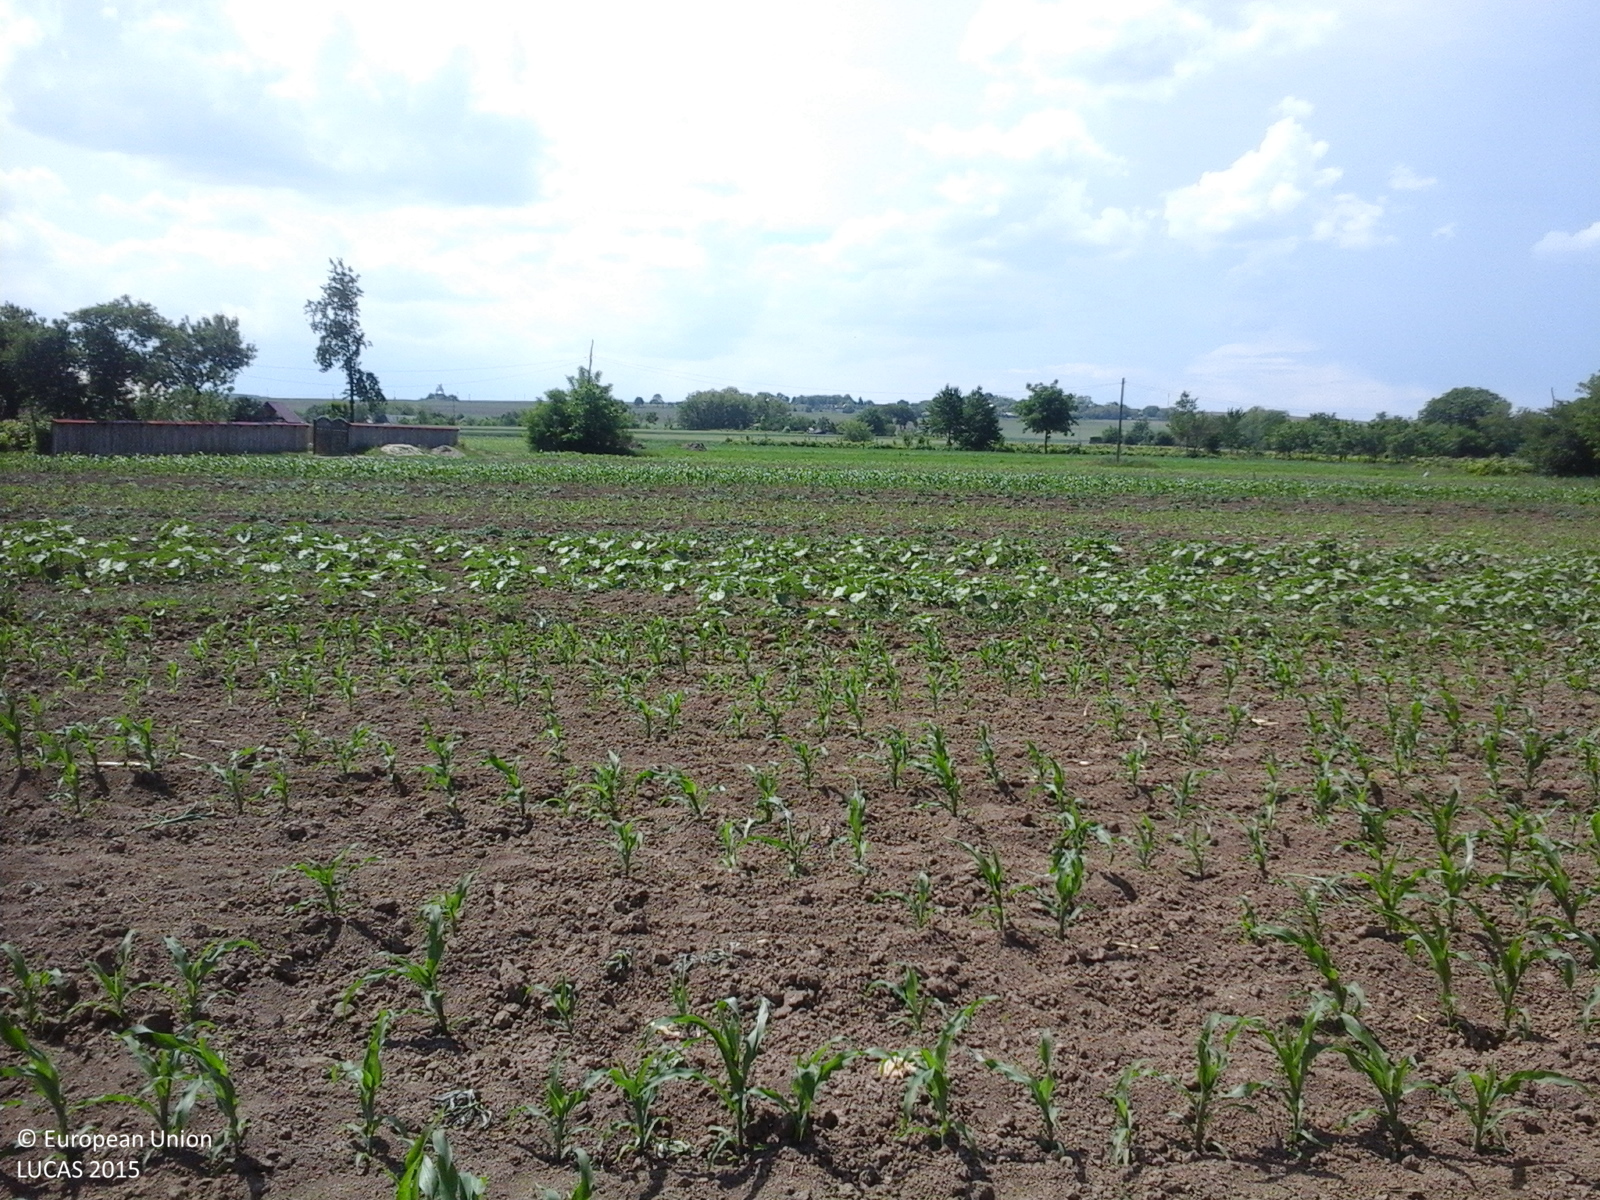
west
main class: Cropland
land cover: Maize
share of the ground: 10 - 25 %
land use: Agriculture (excluding fallow land and kitchen gardens)
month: June
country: RO
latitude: 46.7938
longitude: 26.7960
